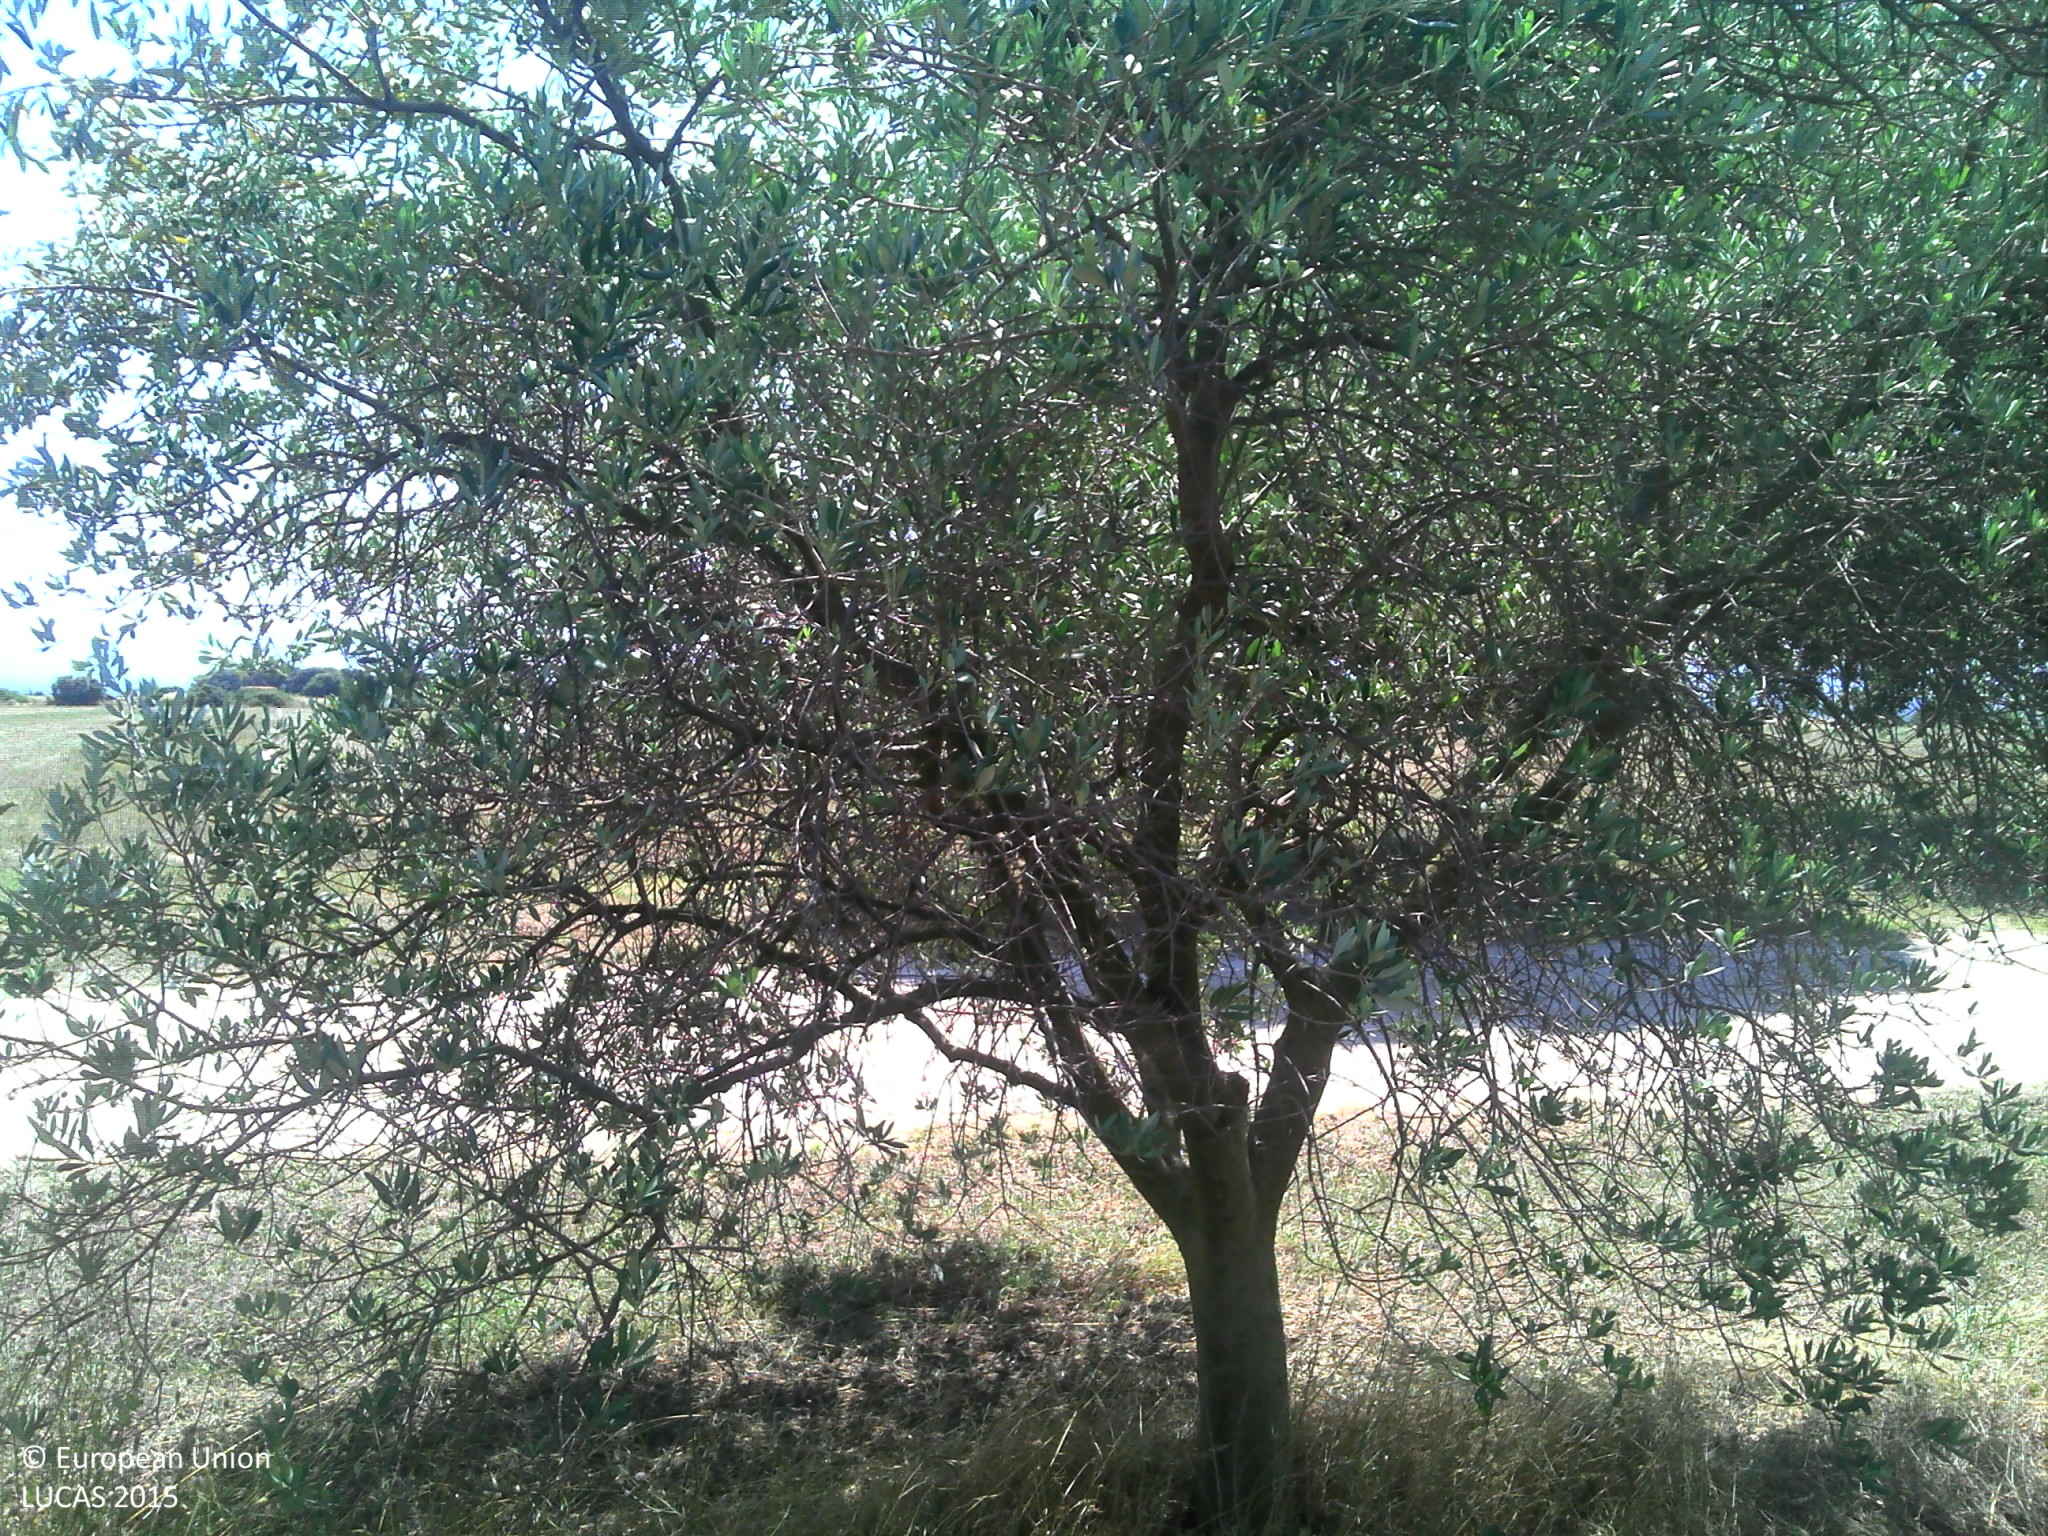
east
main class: Cropland
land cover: Olive groves
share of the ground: 25 - 50 %
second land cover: Grassland without tree/shrub cover
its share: 25 - 50 %
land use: Agriculture (excluding fallow land and kitchen gardens)
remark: Clear cut
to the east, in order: Olive groves; Grassland without tree/shrub cover; Grass margins; Tracks; Grassland with sparse tree/shrub cover; Tracks; Grass margins; Abandoned hedges; Mixed cereals for fodder; Fences; Grassland without tree/shrub cover
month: July
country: FR
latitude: 43.8263
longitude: 4.8734
